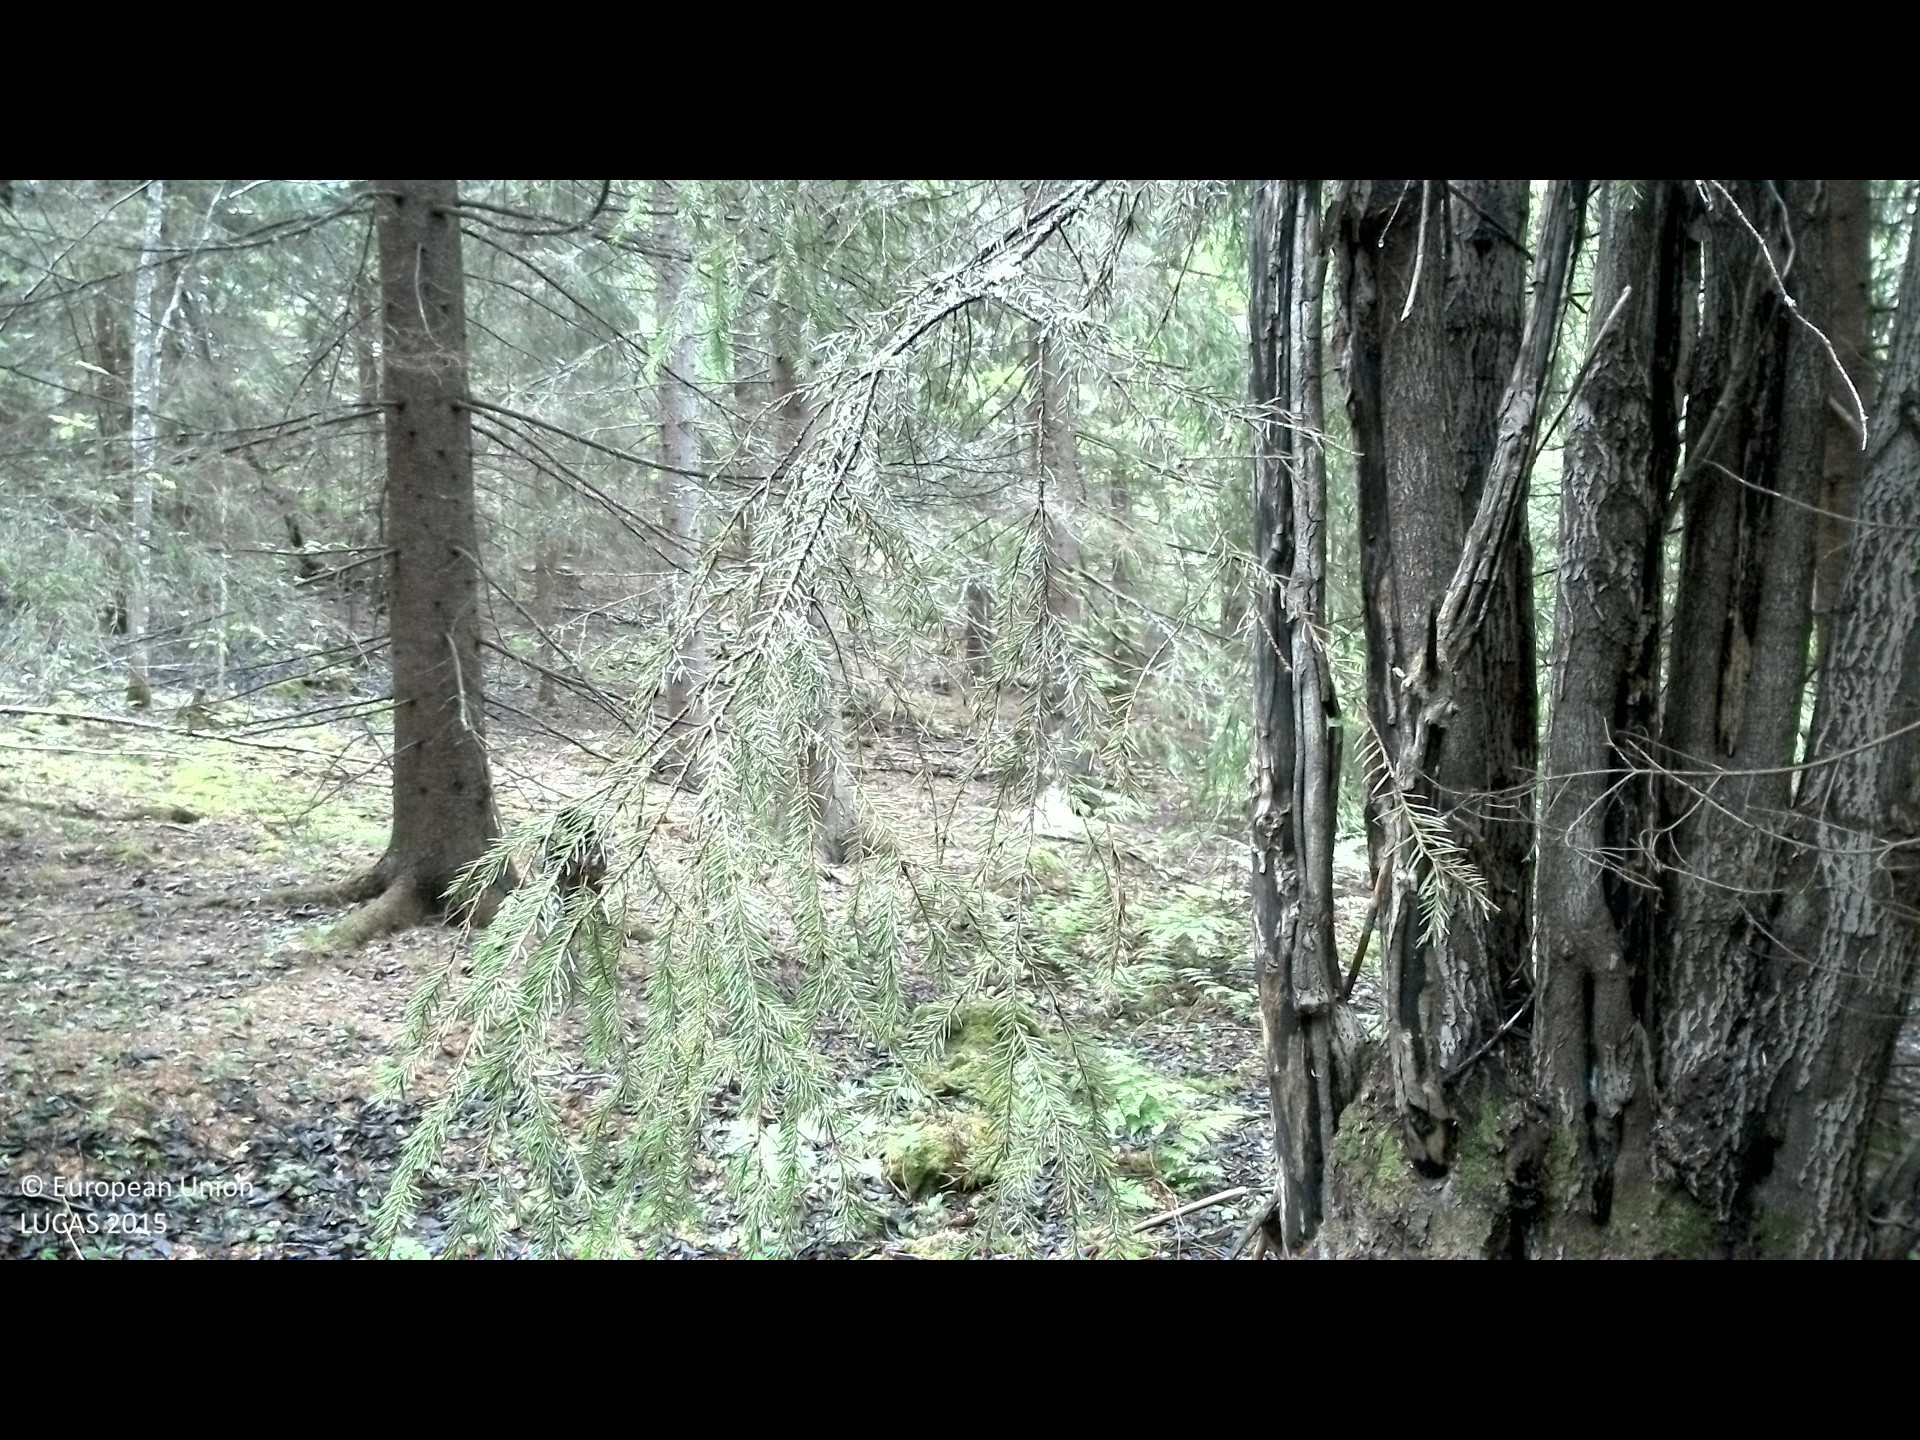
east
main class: Woodland
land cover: Spruce dominated coniferous woodland
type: boreal forest
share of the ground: 50 - 75 %
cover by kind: coniferous forest trees 45 %, herbaceous plants 25 %, lichens and mosses 25 %, broadleaved forest trees 5 %
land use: Forestry
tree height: > 5 m
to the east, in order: Spruce dominated coniferous woodland; Tracks; Spruce dominated coniferous woodland; Spruce dominated mixed woodland; Inland fresh water bodies
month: June
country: SE
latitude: 61.9562
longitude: 17.0943
